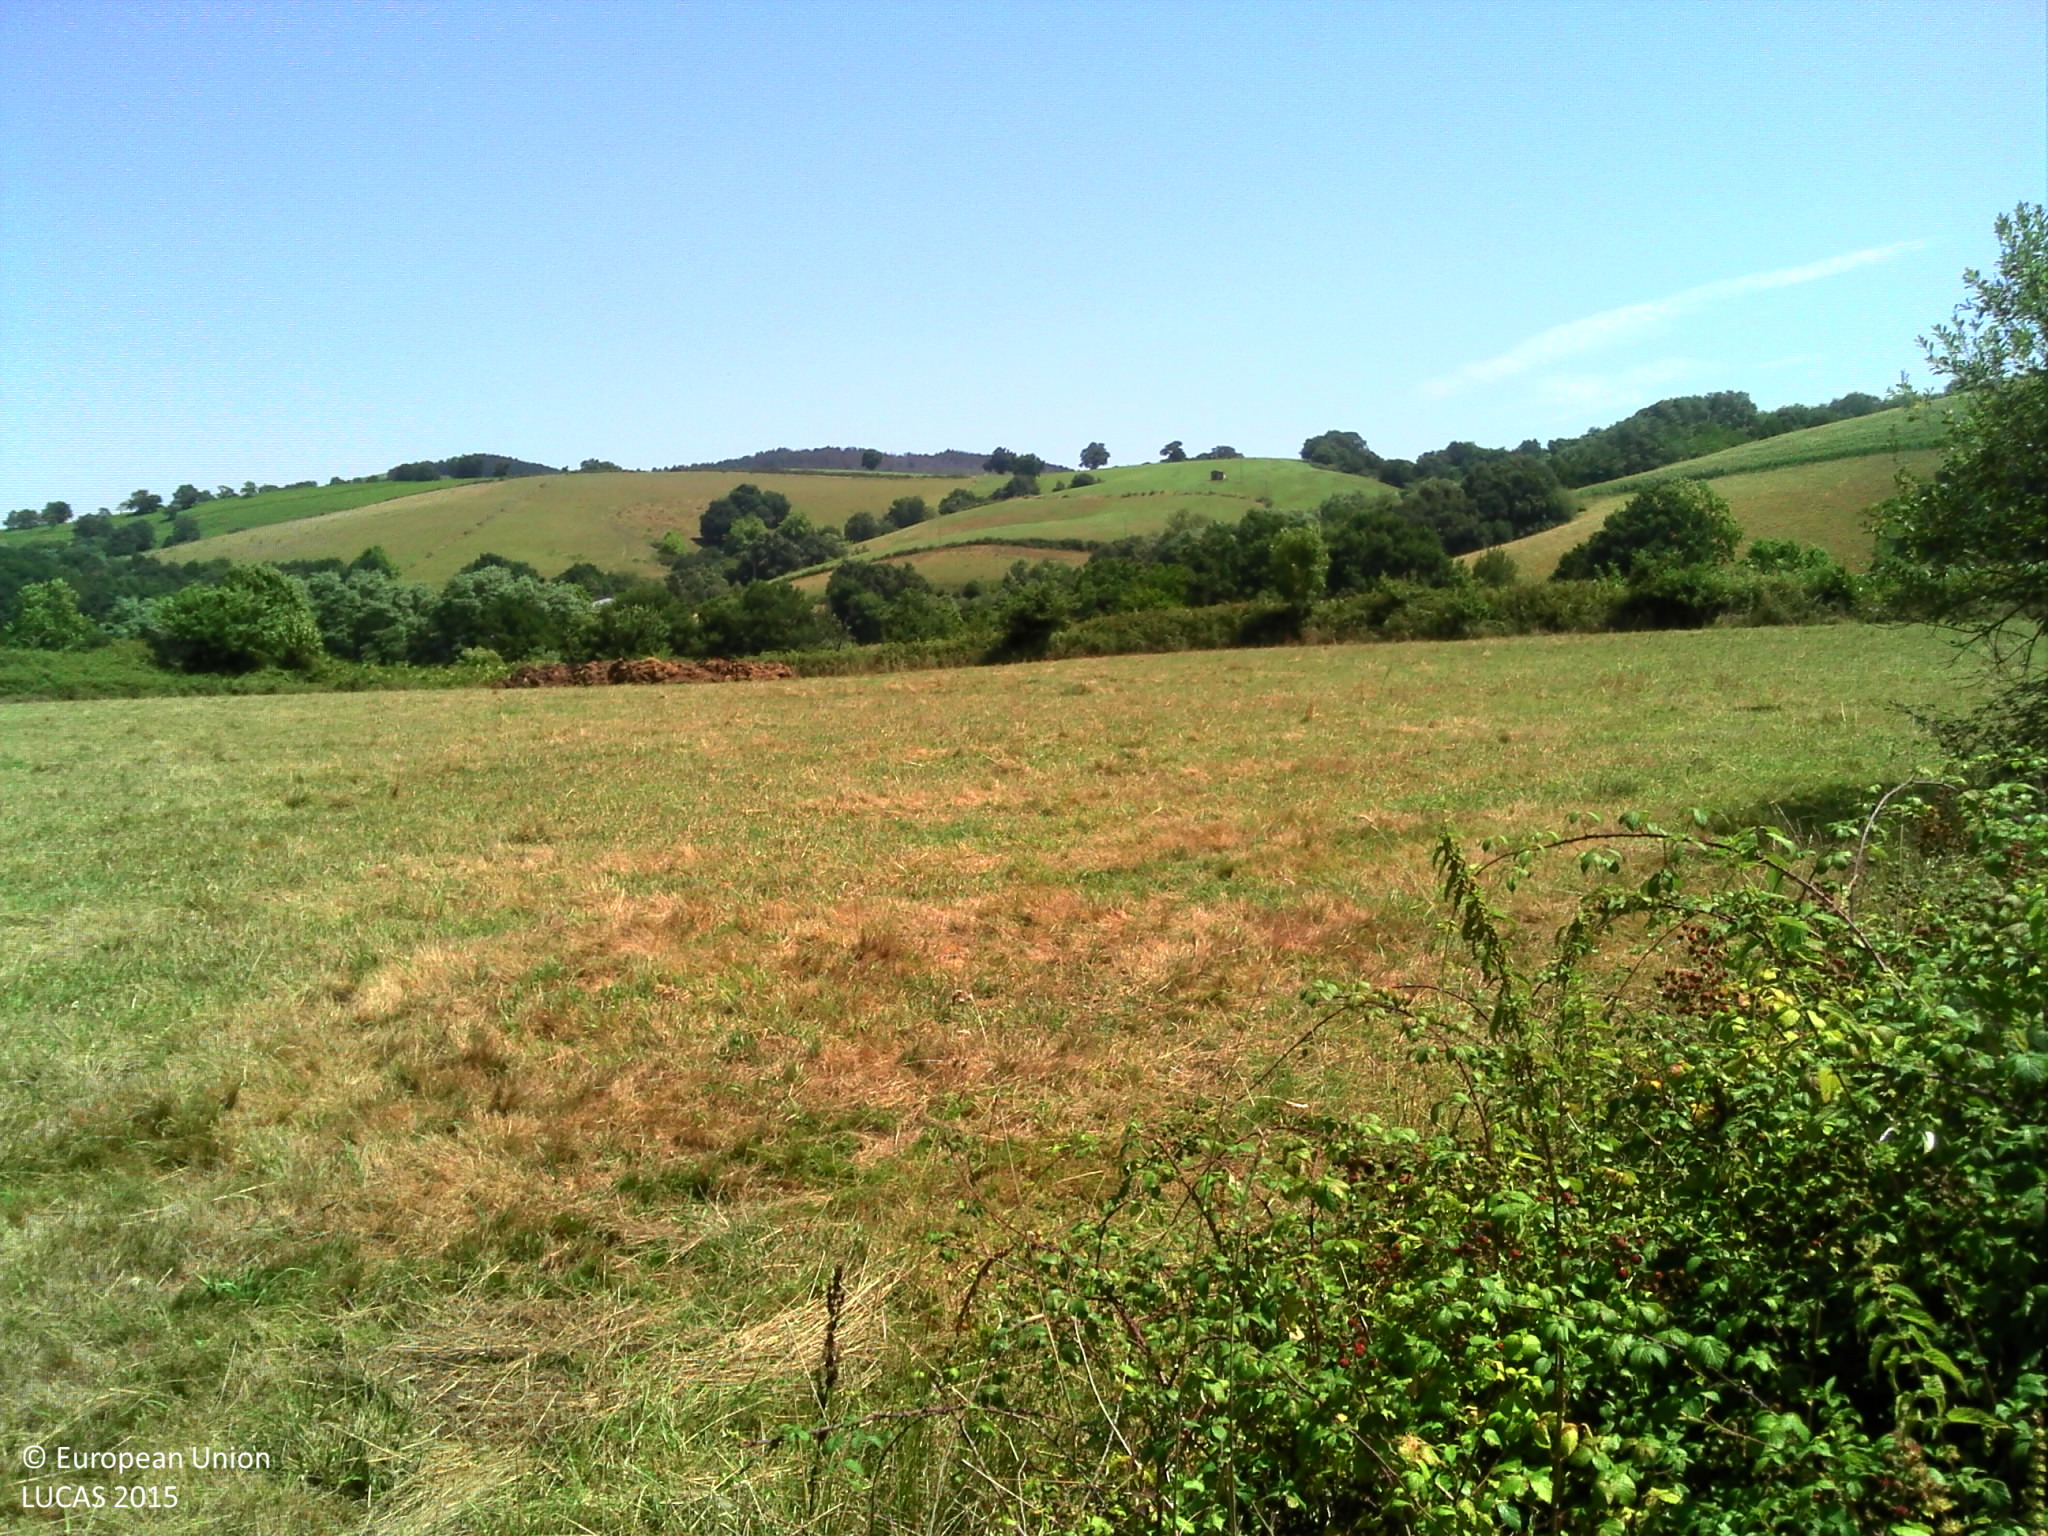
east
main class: Cropland
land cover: Maize
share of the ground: > 75 %
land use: Agriculture (excluding fallow land and kitchen gardens)
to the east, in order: Maize; Grassland without tree/shrub cover
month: August
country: FR
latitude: 43.3113
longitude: -1.1469
